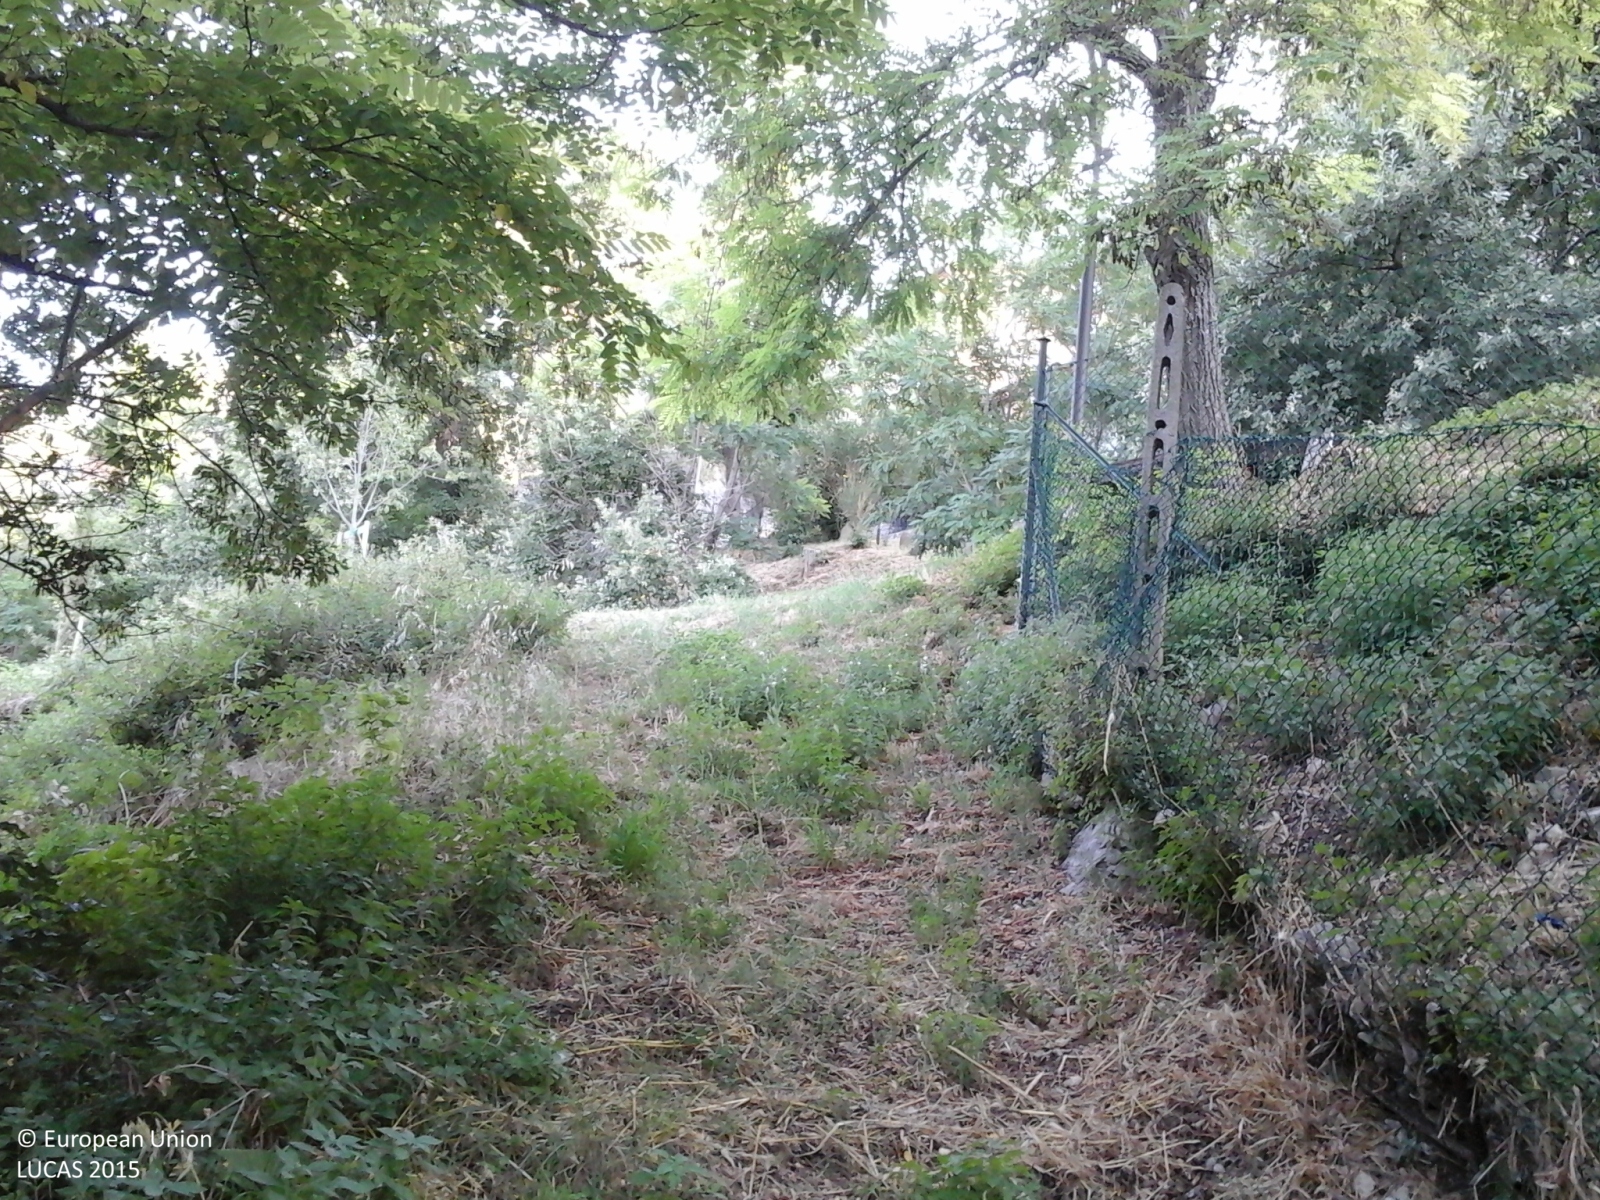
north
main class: Woodland
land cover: Broadleaved woodland
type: thermophilous deciduous forest
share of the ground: > 75 %
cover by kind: broadleaved forest trees 100 %
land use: Semi-natural and natural areas not in use
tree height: > 5 m
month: July
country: IT
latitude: 43.9991
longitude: 12.3514
